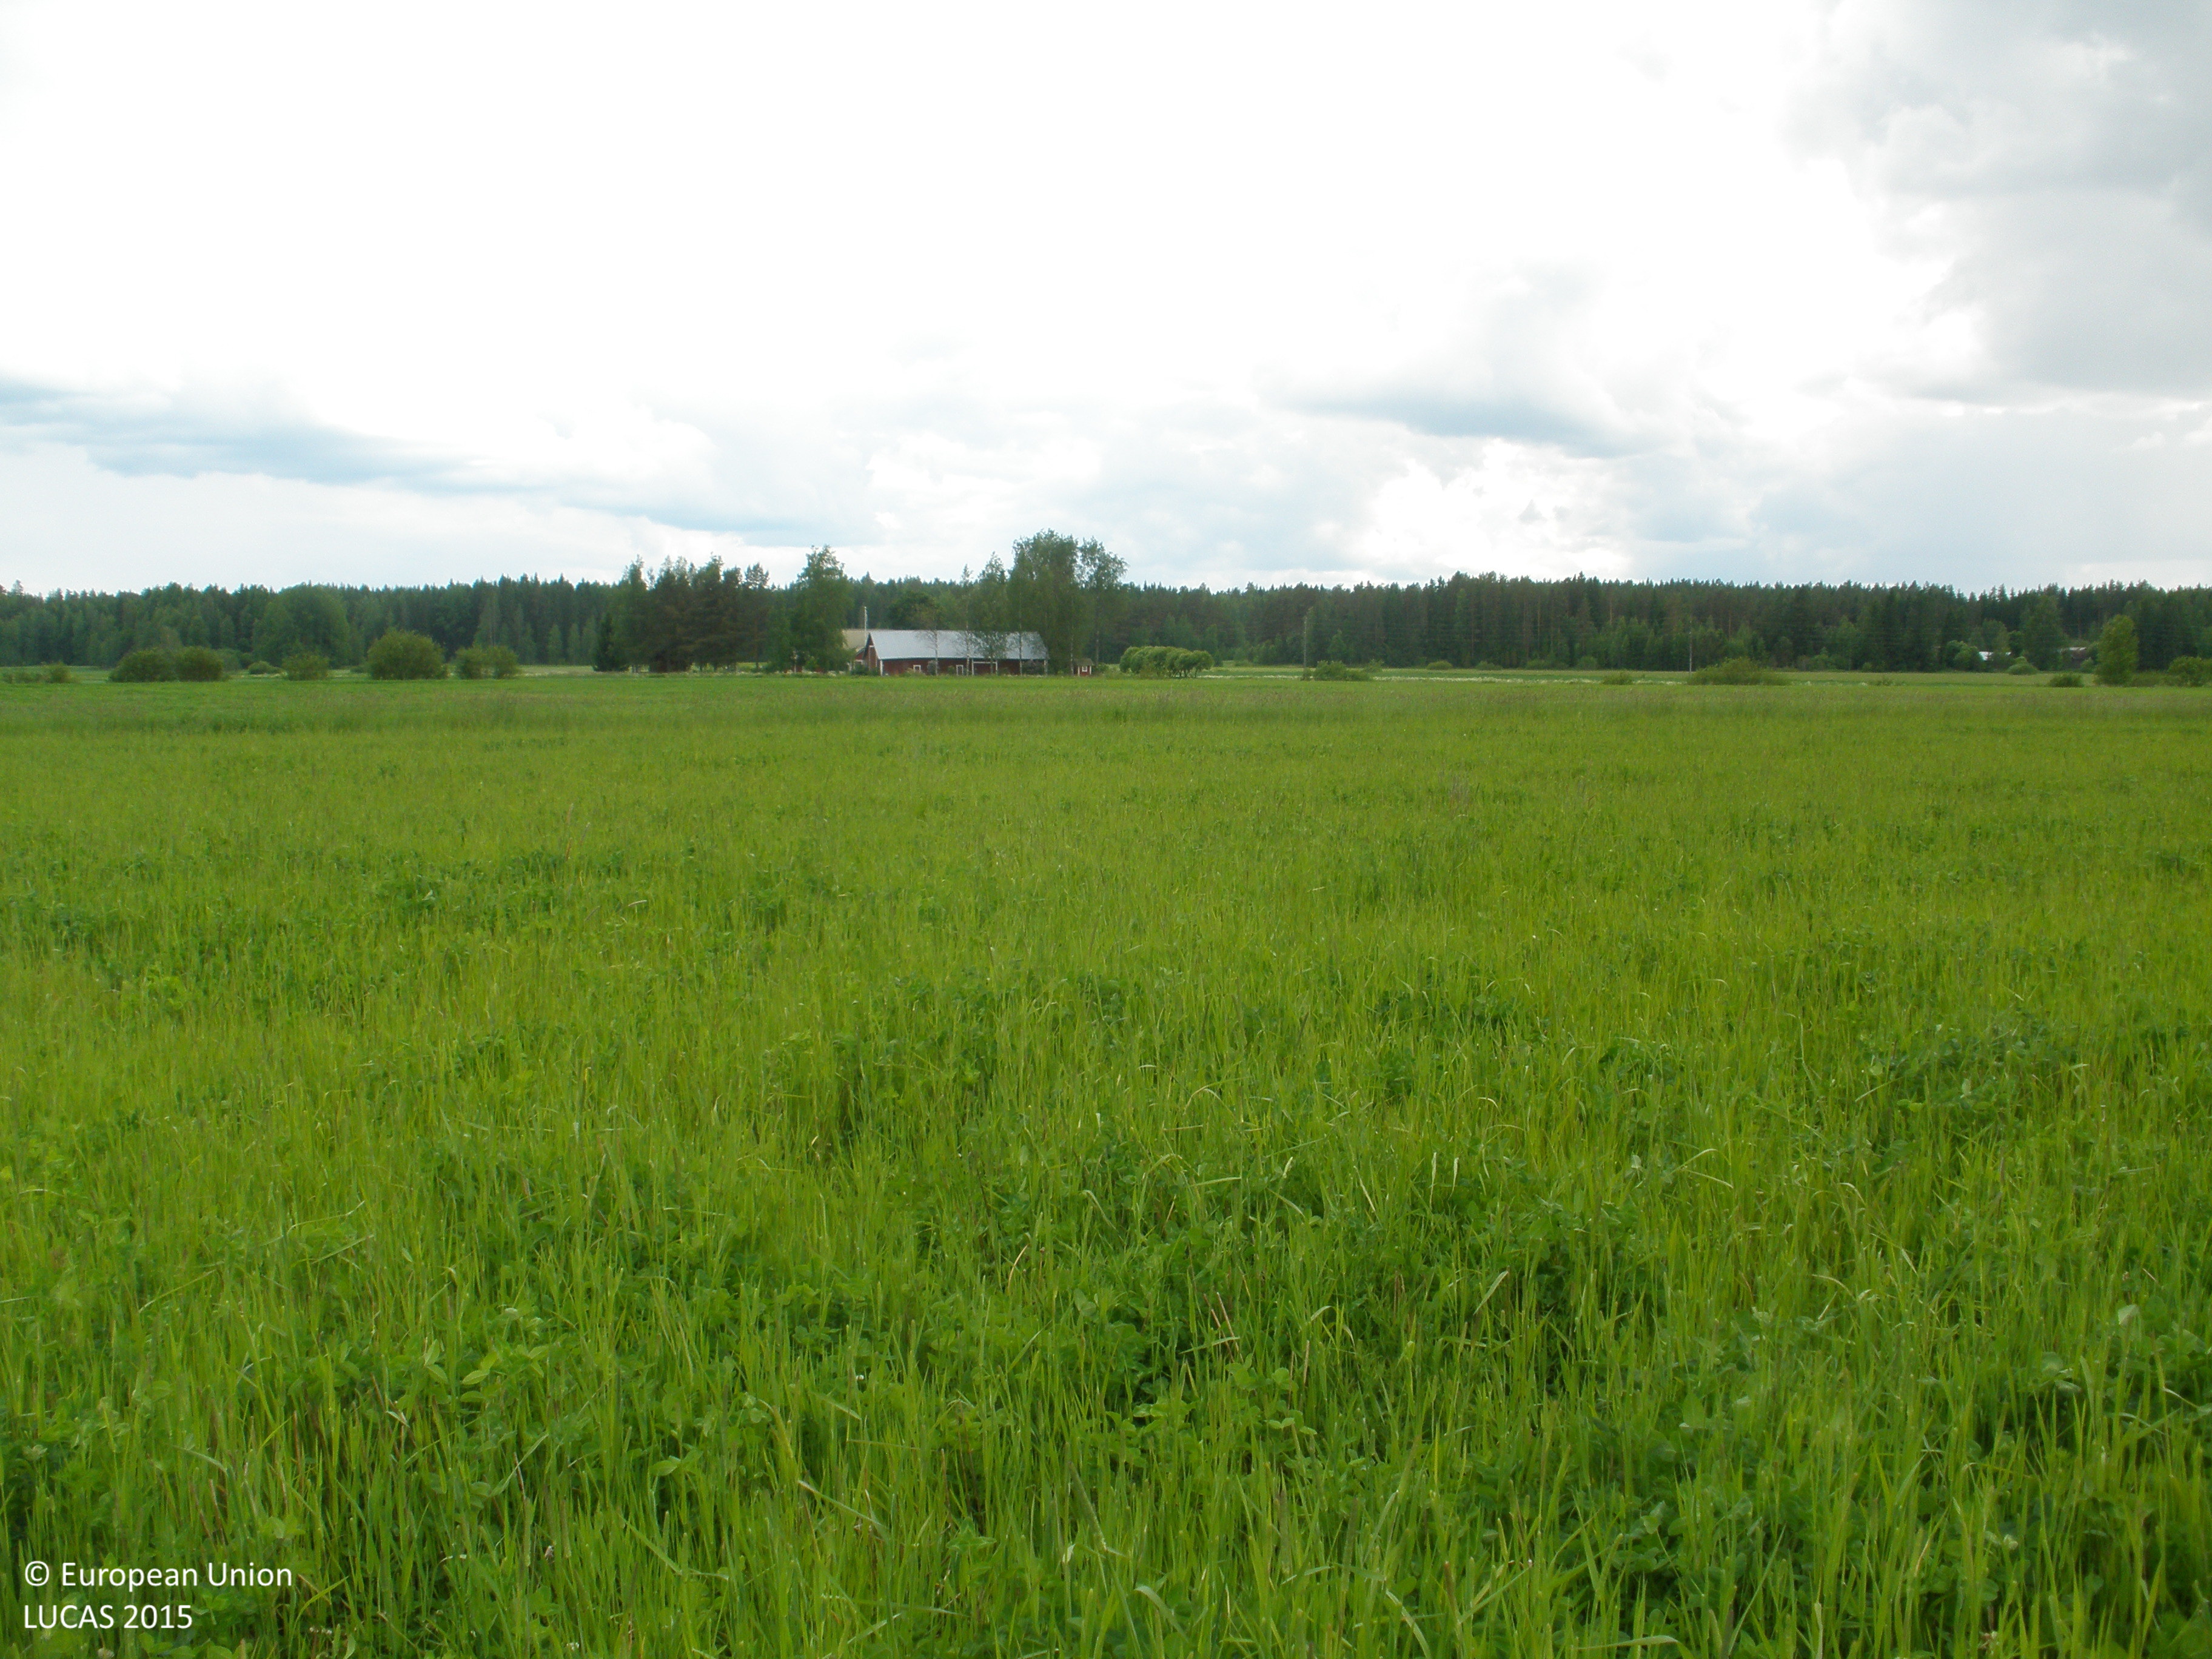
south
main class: Cropland
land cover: Other leguminous and mixtures for fodder
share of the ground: > 75 %
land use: Agriculture (excluding fallow land and kitchen gardens)
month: June
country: FI
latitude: 61.0671
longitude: 23.2908
